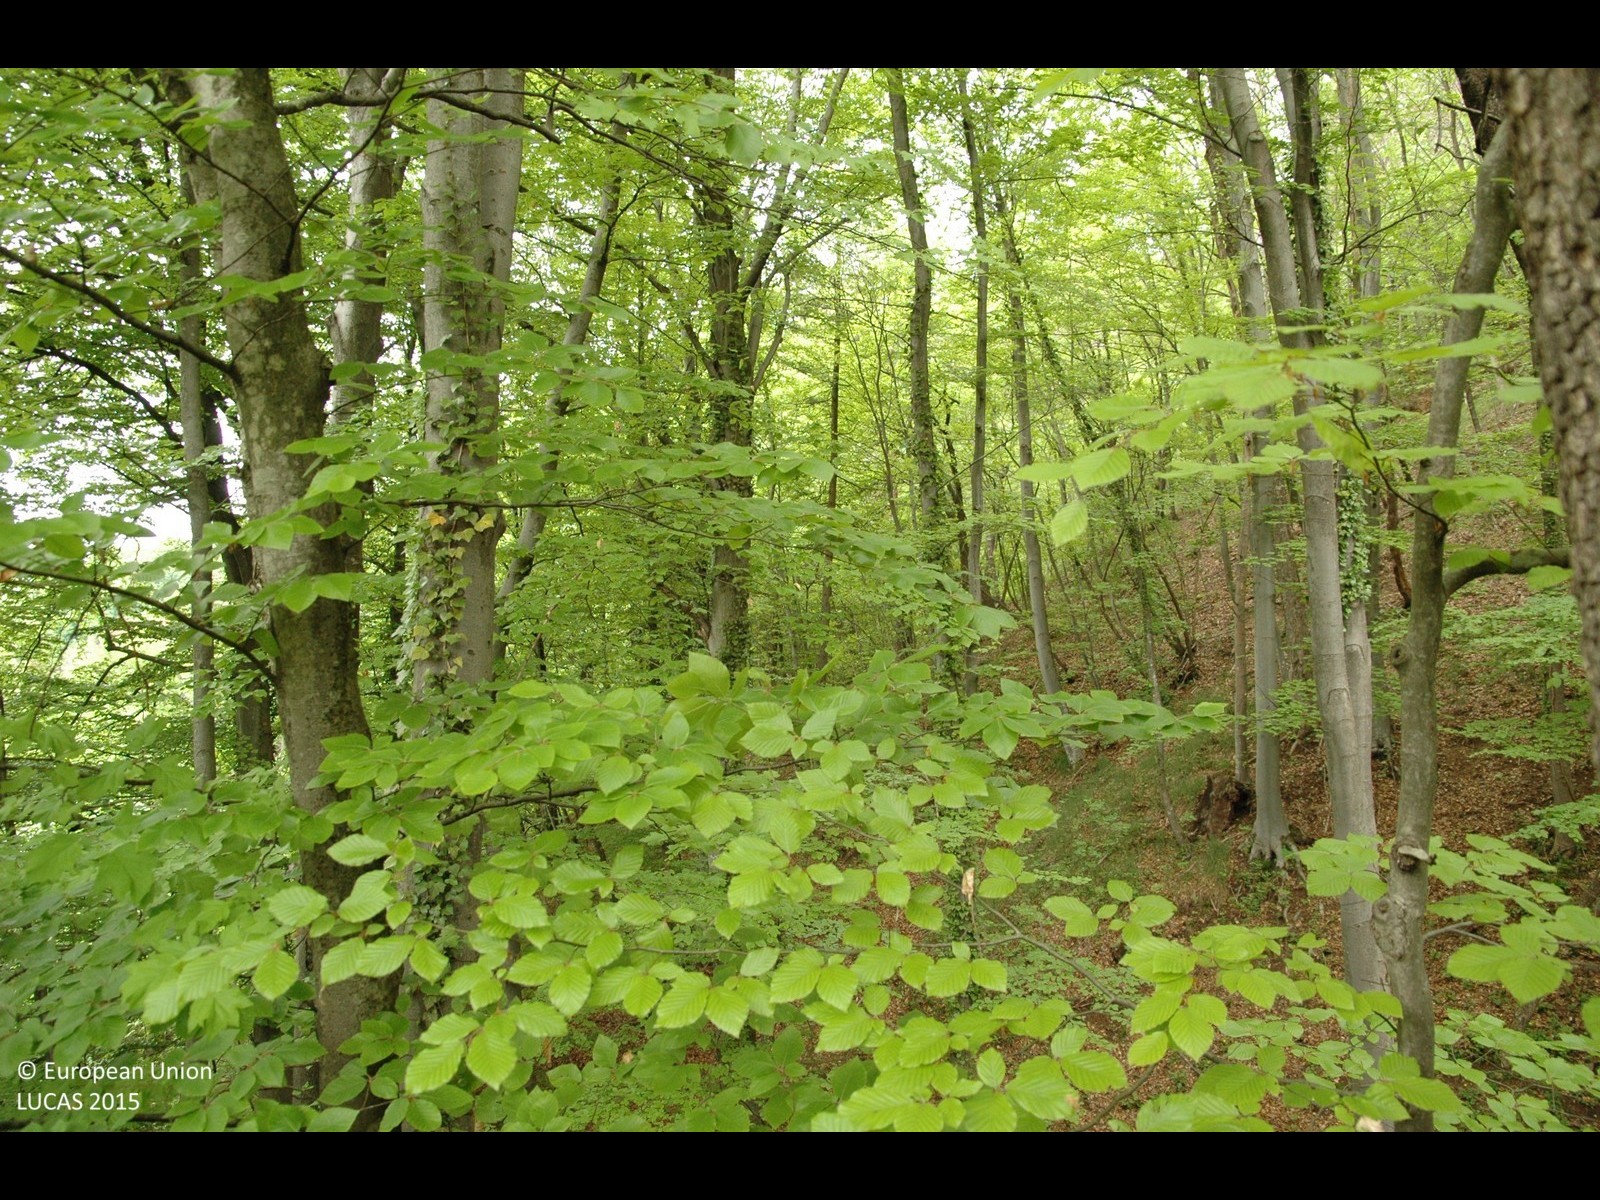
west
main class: Woodland
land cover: Broadleaved woodland
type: beech forest
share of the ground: > 75 %
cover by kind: broadleaved forest trees 95 %, consolidated bare surface 5 %
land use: Forestry
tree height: > 5 m
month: May
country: HR
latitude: 45.8021
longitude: 15.6972
